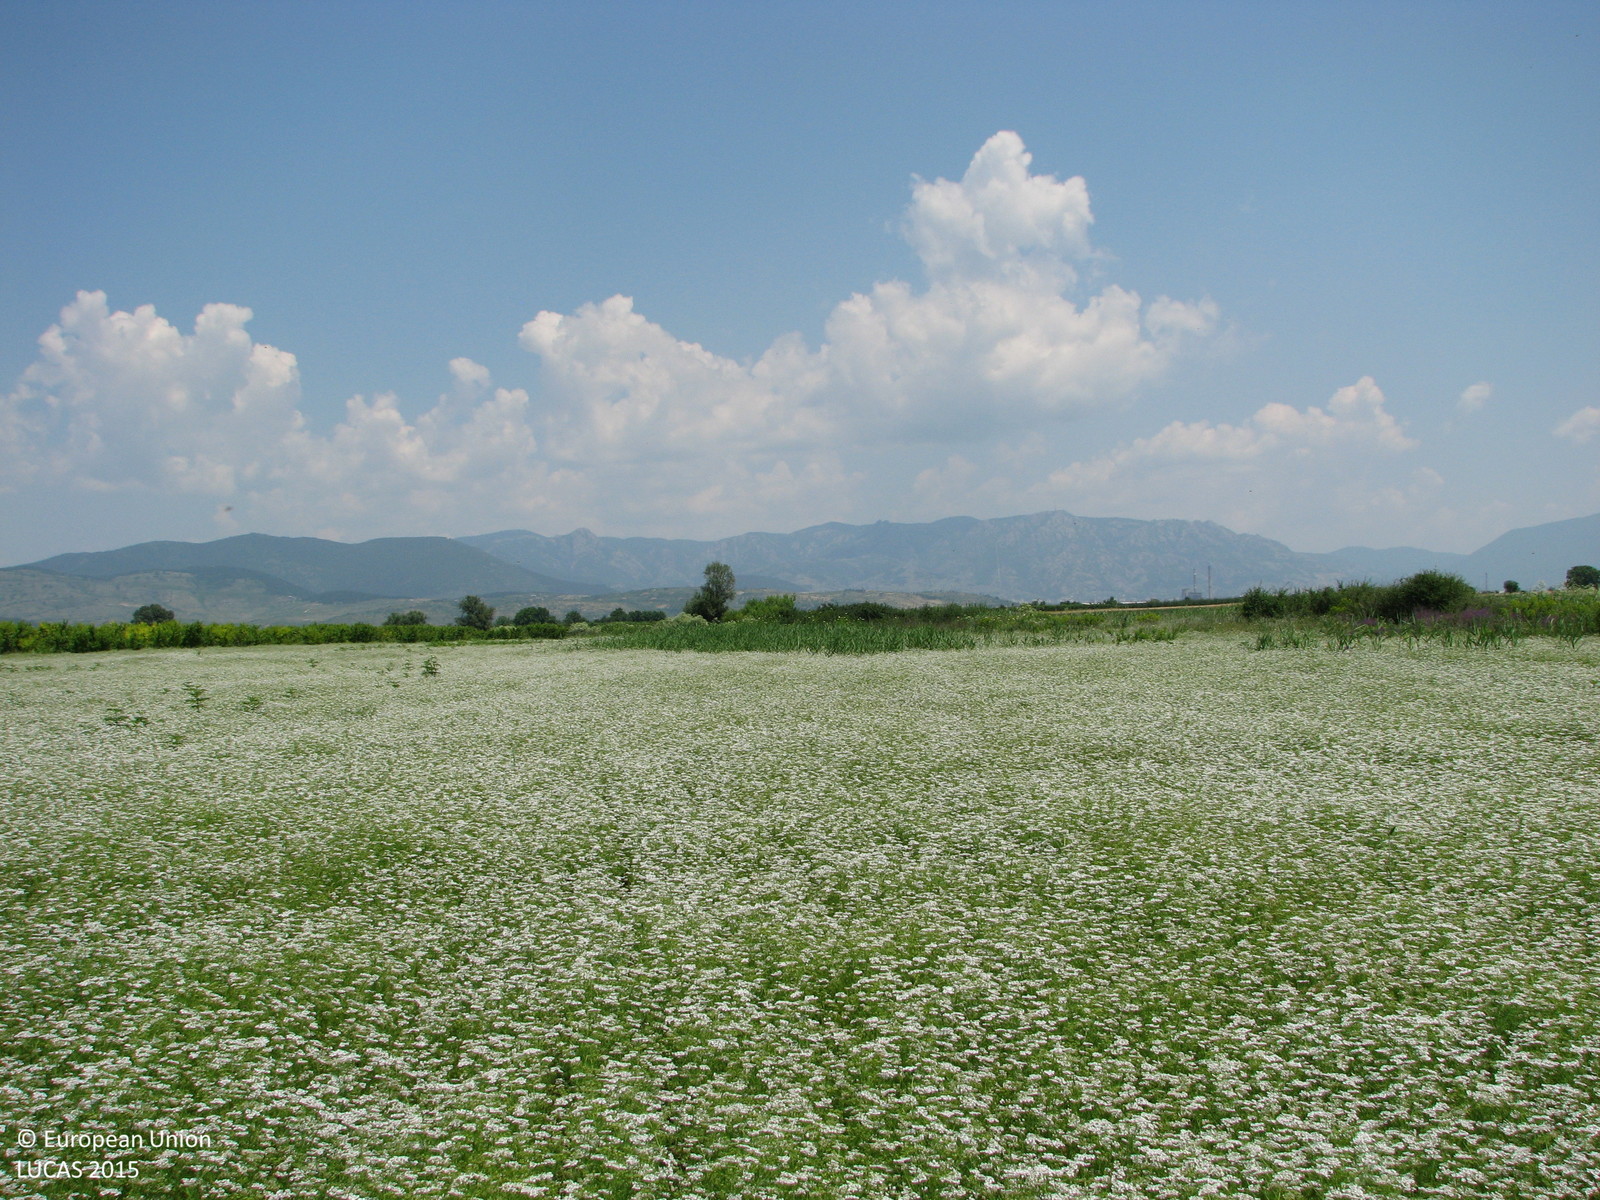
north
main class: Cropland
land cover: Other non-permanent industrial crops
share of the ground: > 75 %
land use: Agriculture (excluding fallow land and kitchen gardens)
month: June
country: BG
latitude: 42.6118
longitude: 26.2897
